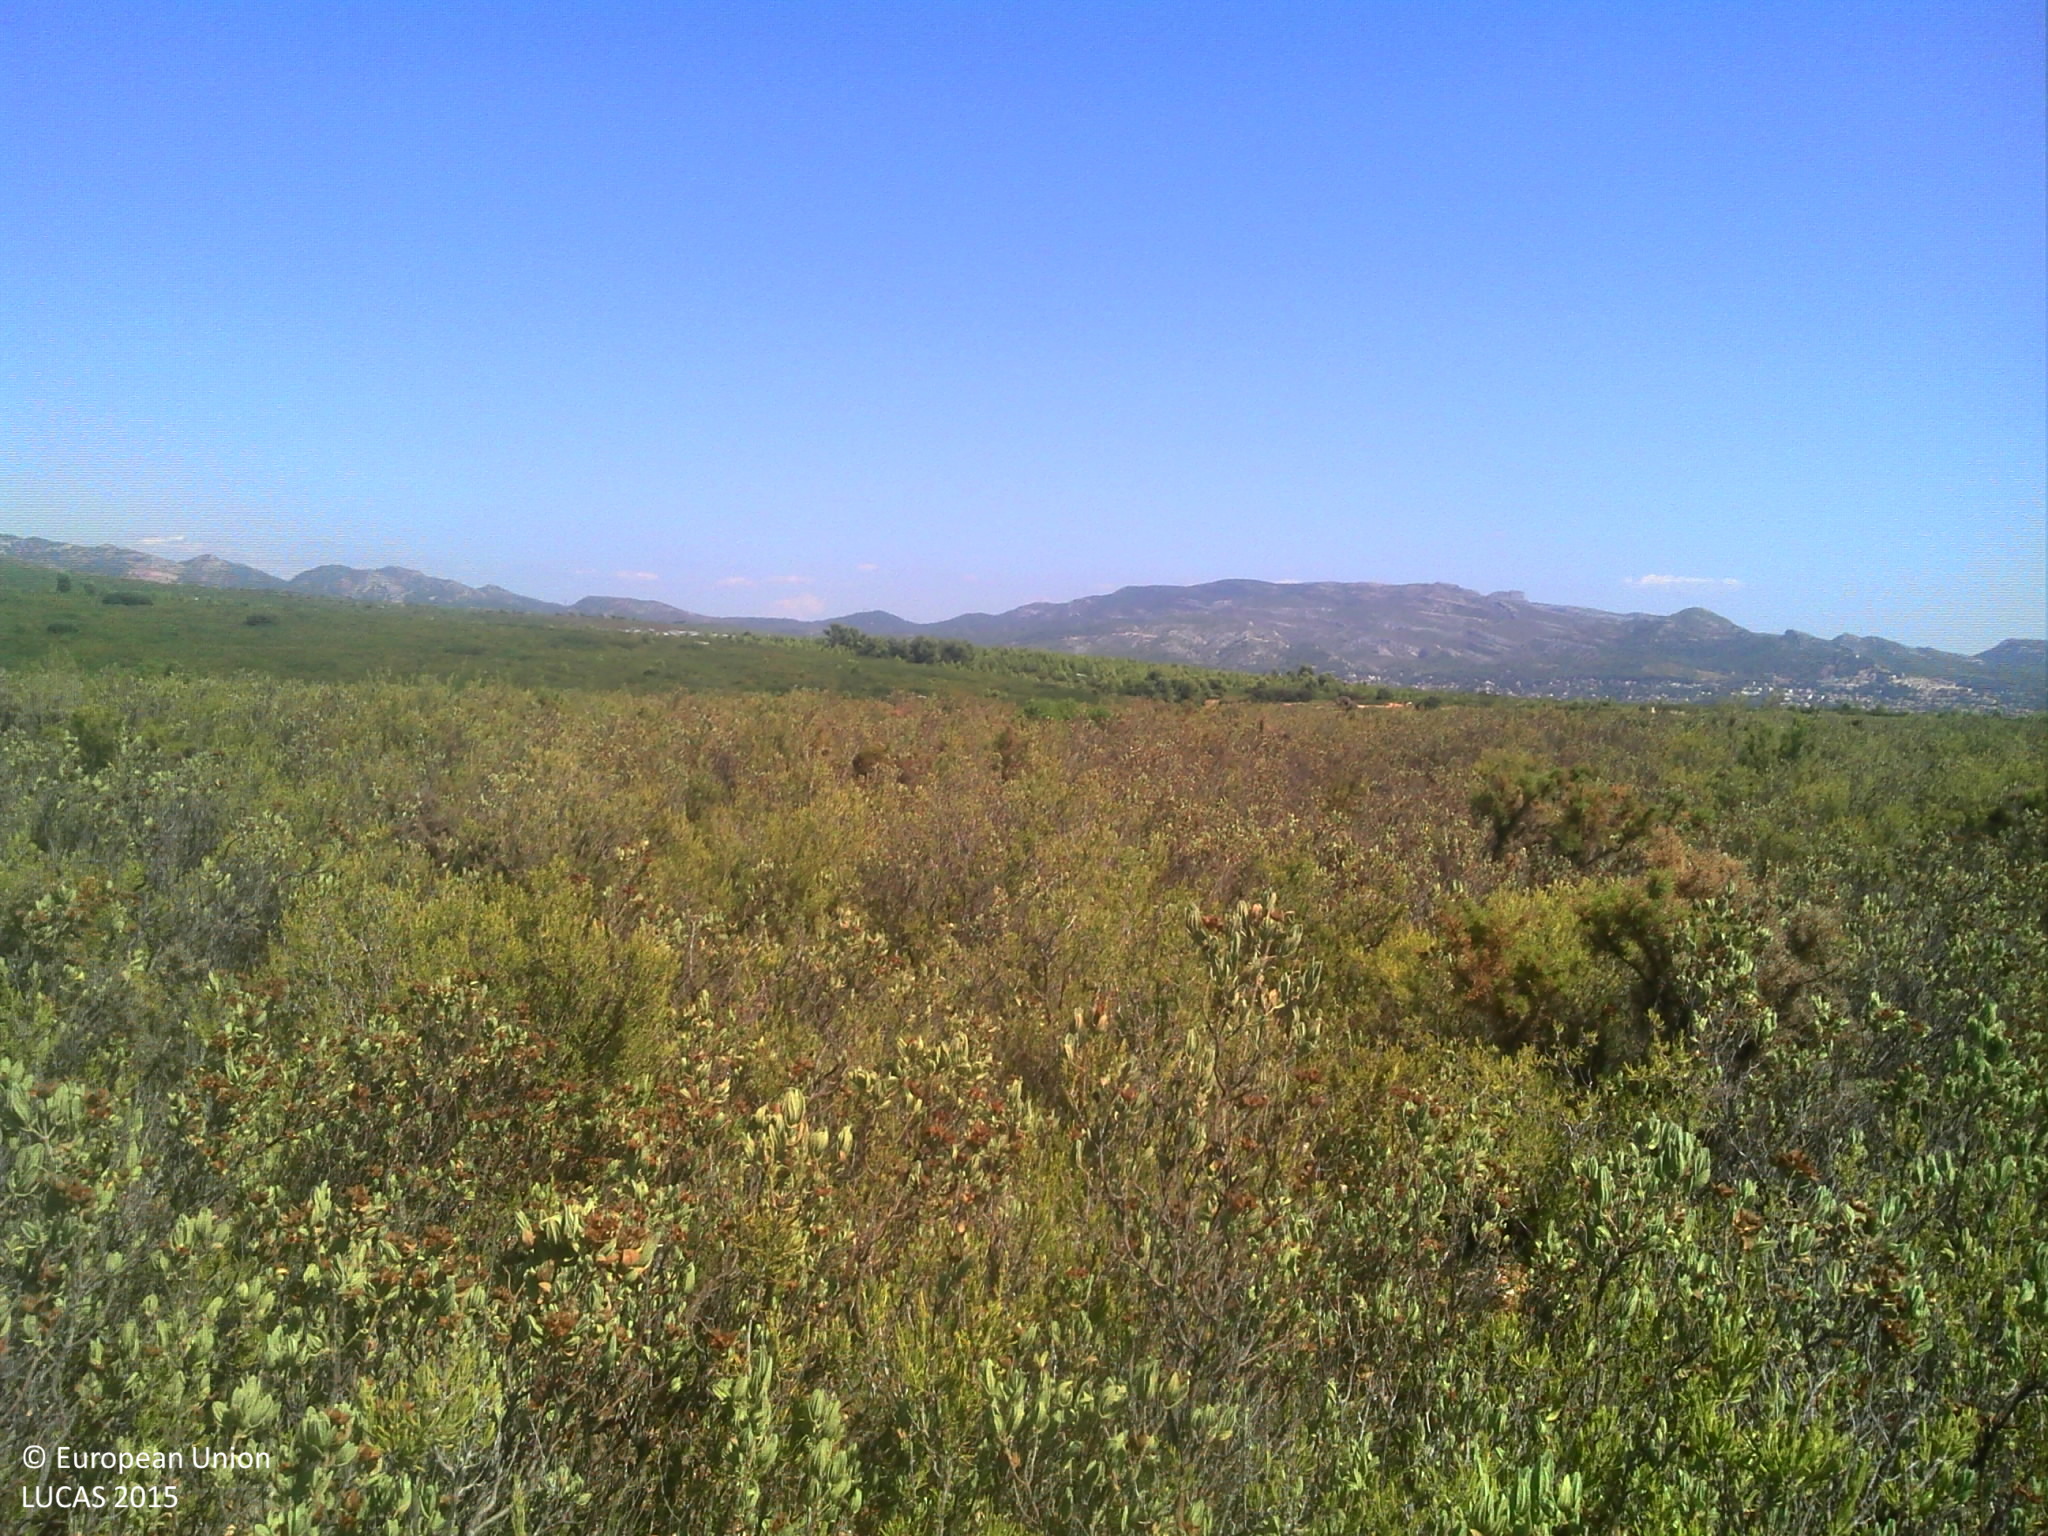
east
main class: Shrubland
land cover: Shrubland without tree cover
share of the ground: > 75 %
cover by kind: shrubs 100 %
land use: Semi-natural and natural areas not in use
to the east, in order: Shrubland without tree cover; Tracks; Shrubland without tree cover; Shrubland with sparse tree cover
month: August
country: FR
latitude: 43.3635
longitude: 5.4074
